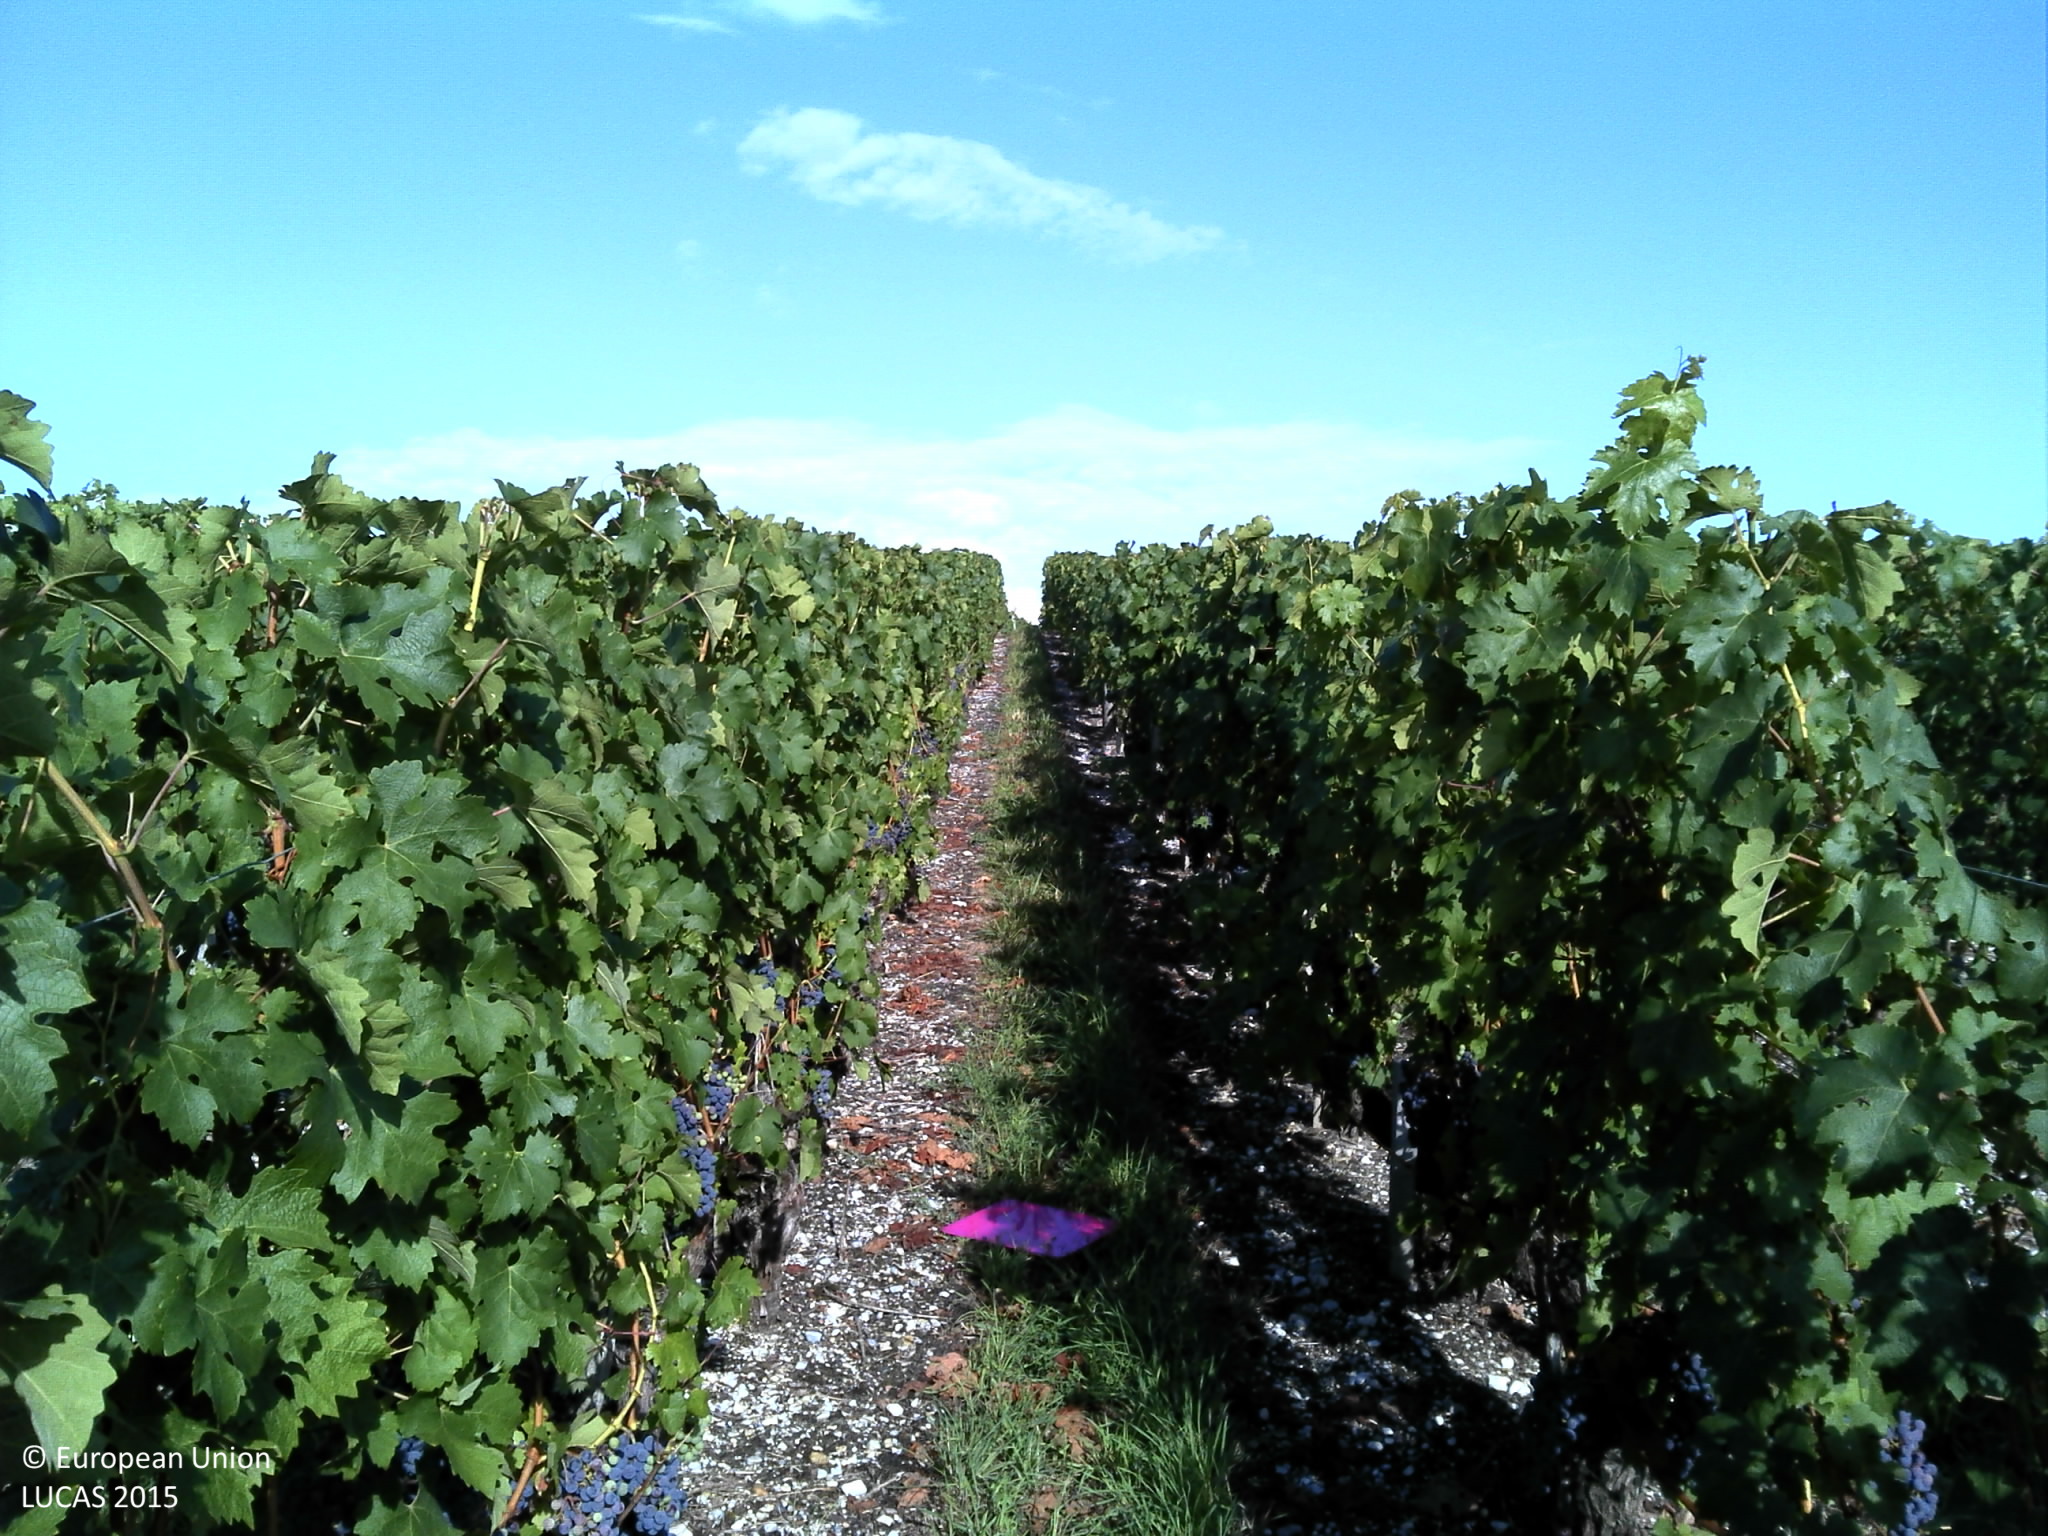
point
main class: Cropland
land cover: Vineyards
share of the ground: 25 - 50 %
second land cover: Grassland without tree/shrub cover
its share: > 75 %
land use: Agriculture (excluding fallow land and kitchen gardens)
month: August
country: FR
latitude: 45.1517
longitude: -0.7702
